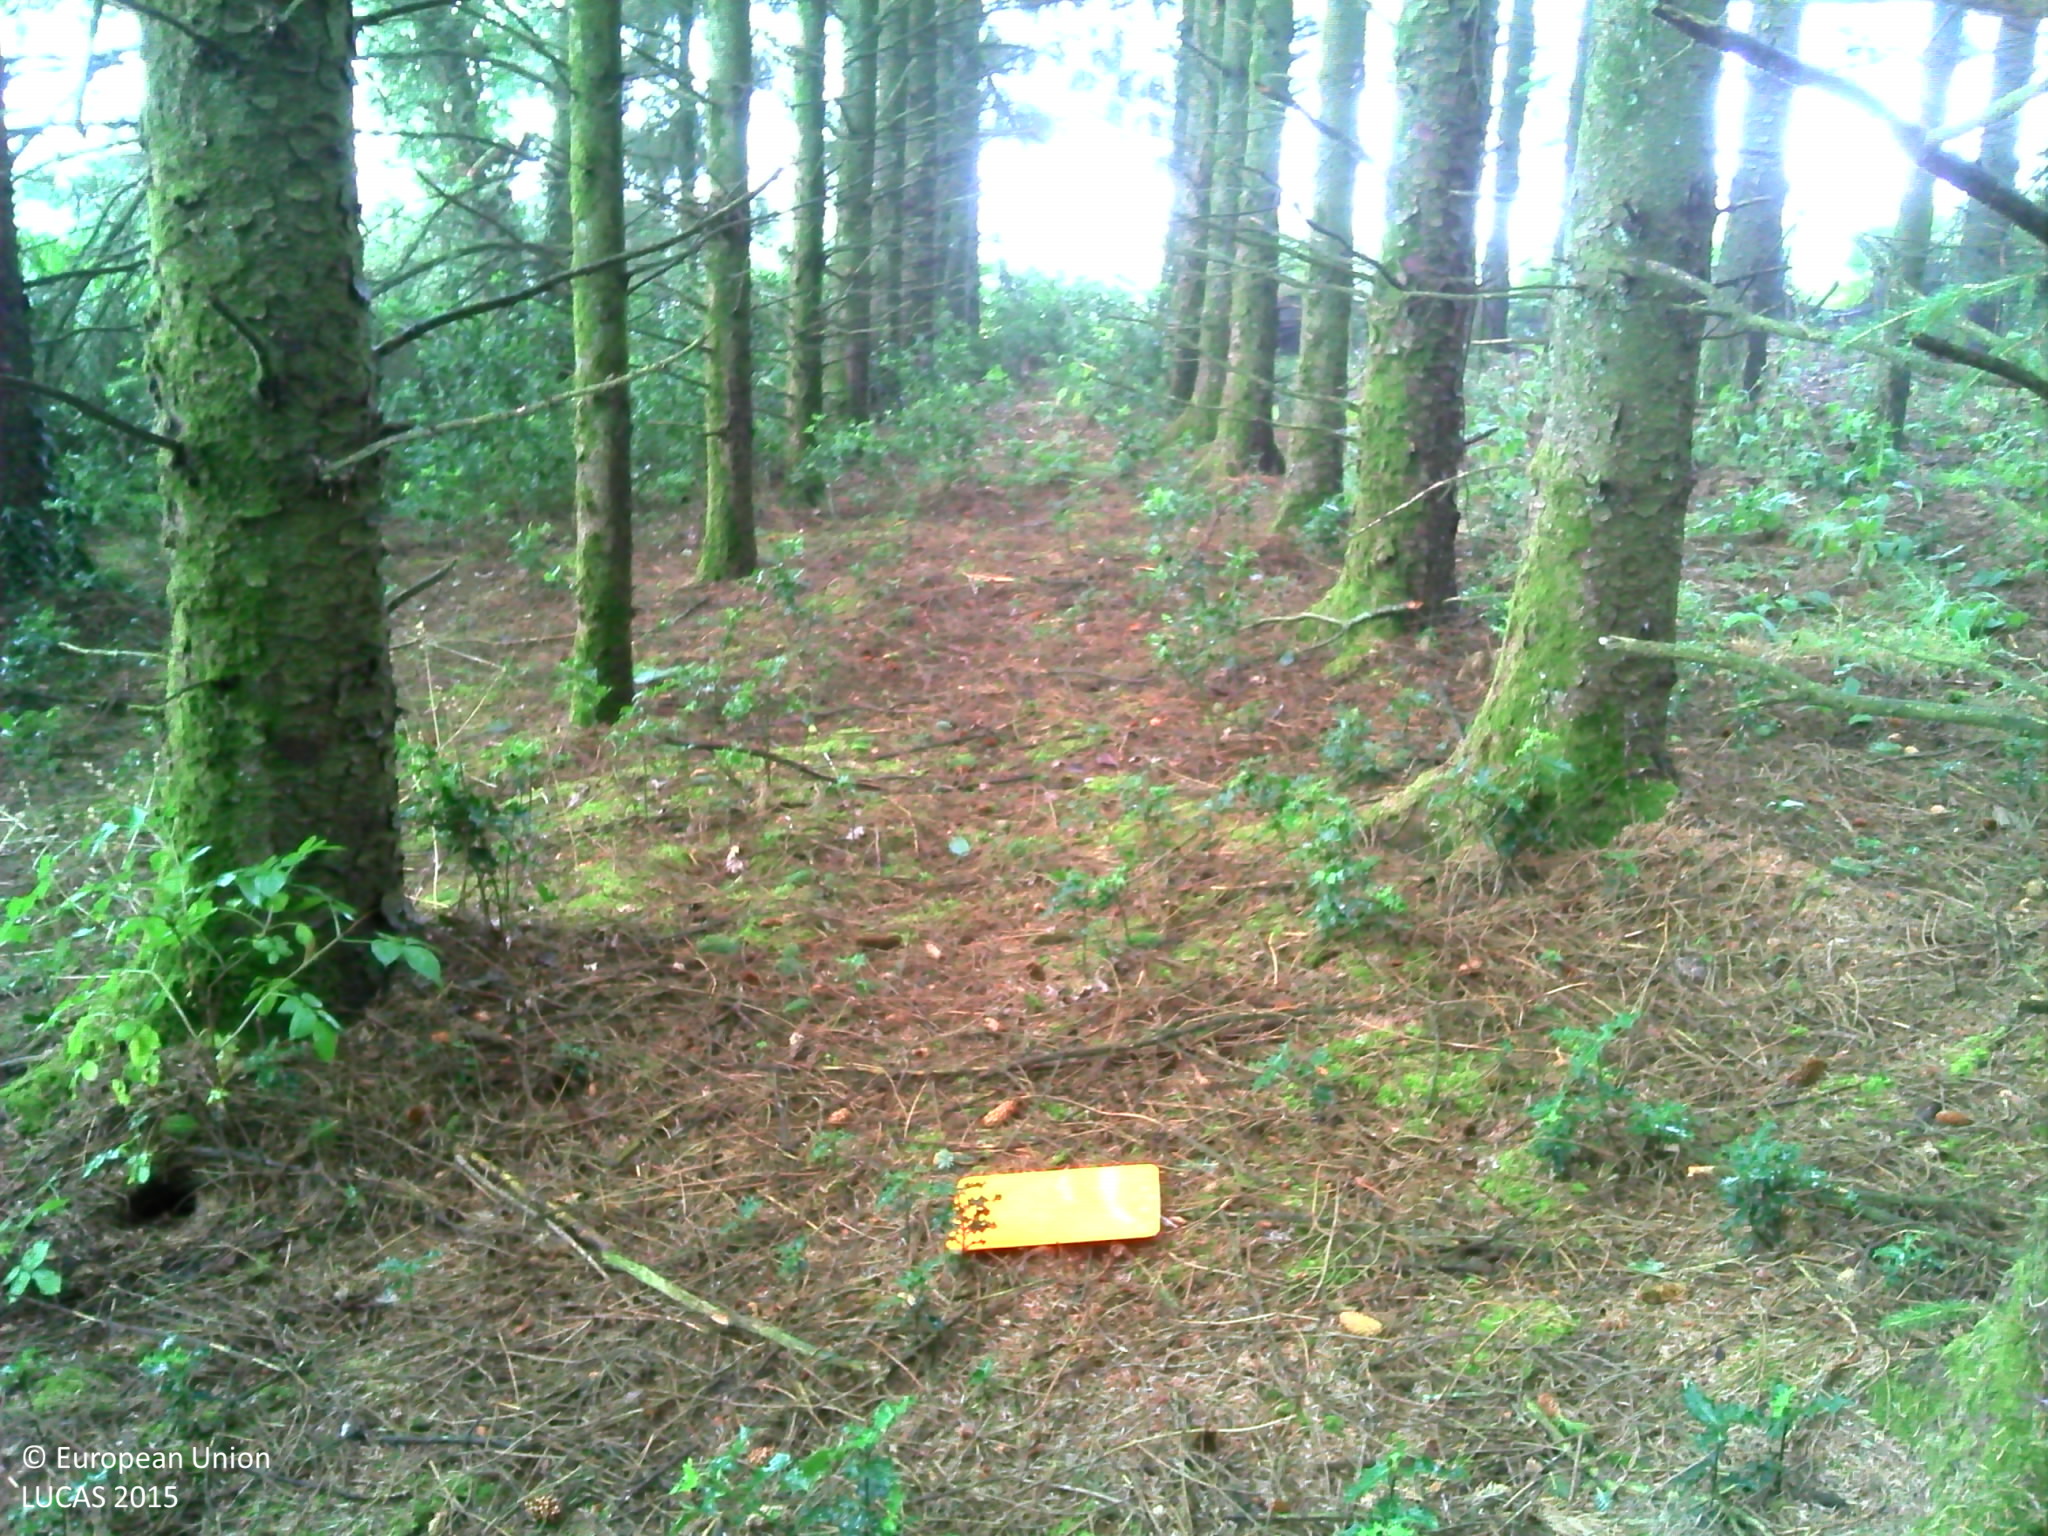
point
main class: Woodland
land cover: Other coniferous woodland
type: exotic forest
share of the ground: > 75 %
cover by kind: coniferous forest trees 90 %, herbaceous plants 10 %
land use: Forestry
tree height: > 5 m
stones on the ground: < 10 %
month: August
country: FR
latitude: 48.3998
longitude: -3.1333
